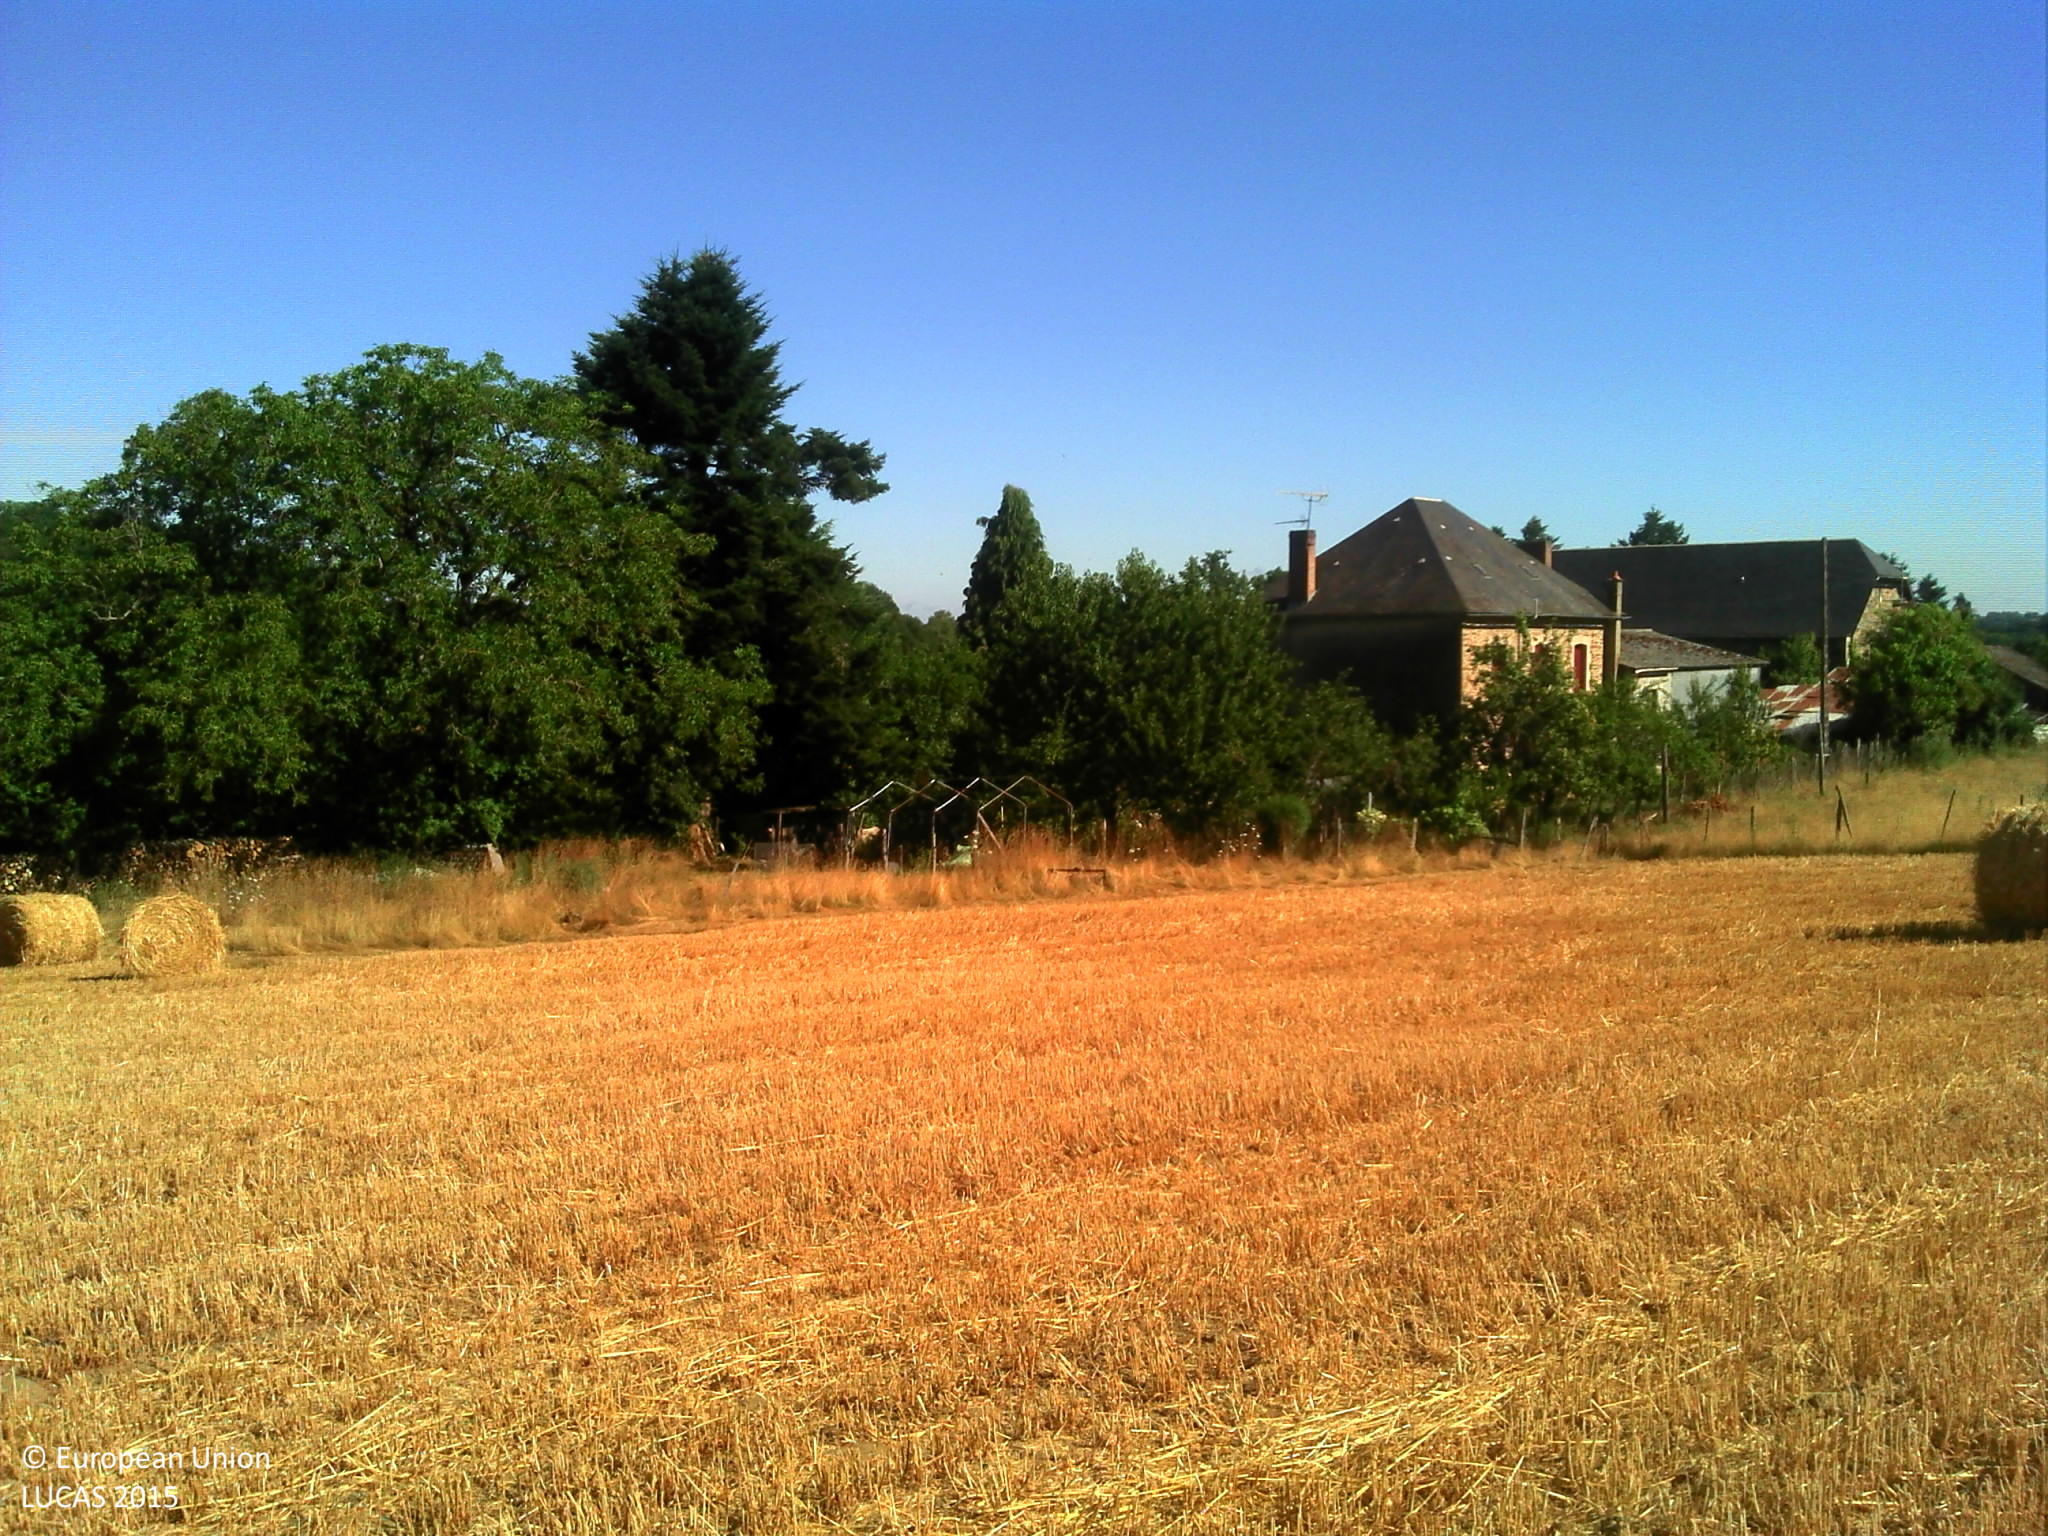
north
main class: Cropland
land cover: Durum wheat
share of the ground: > 75 %
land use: Agriculture (excluding fallow land and kitchen gardens)
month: July
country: FR
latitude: 45.6112
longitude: 1.4657
